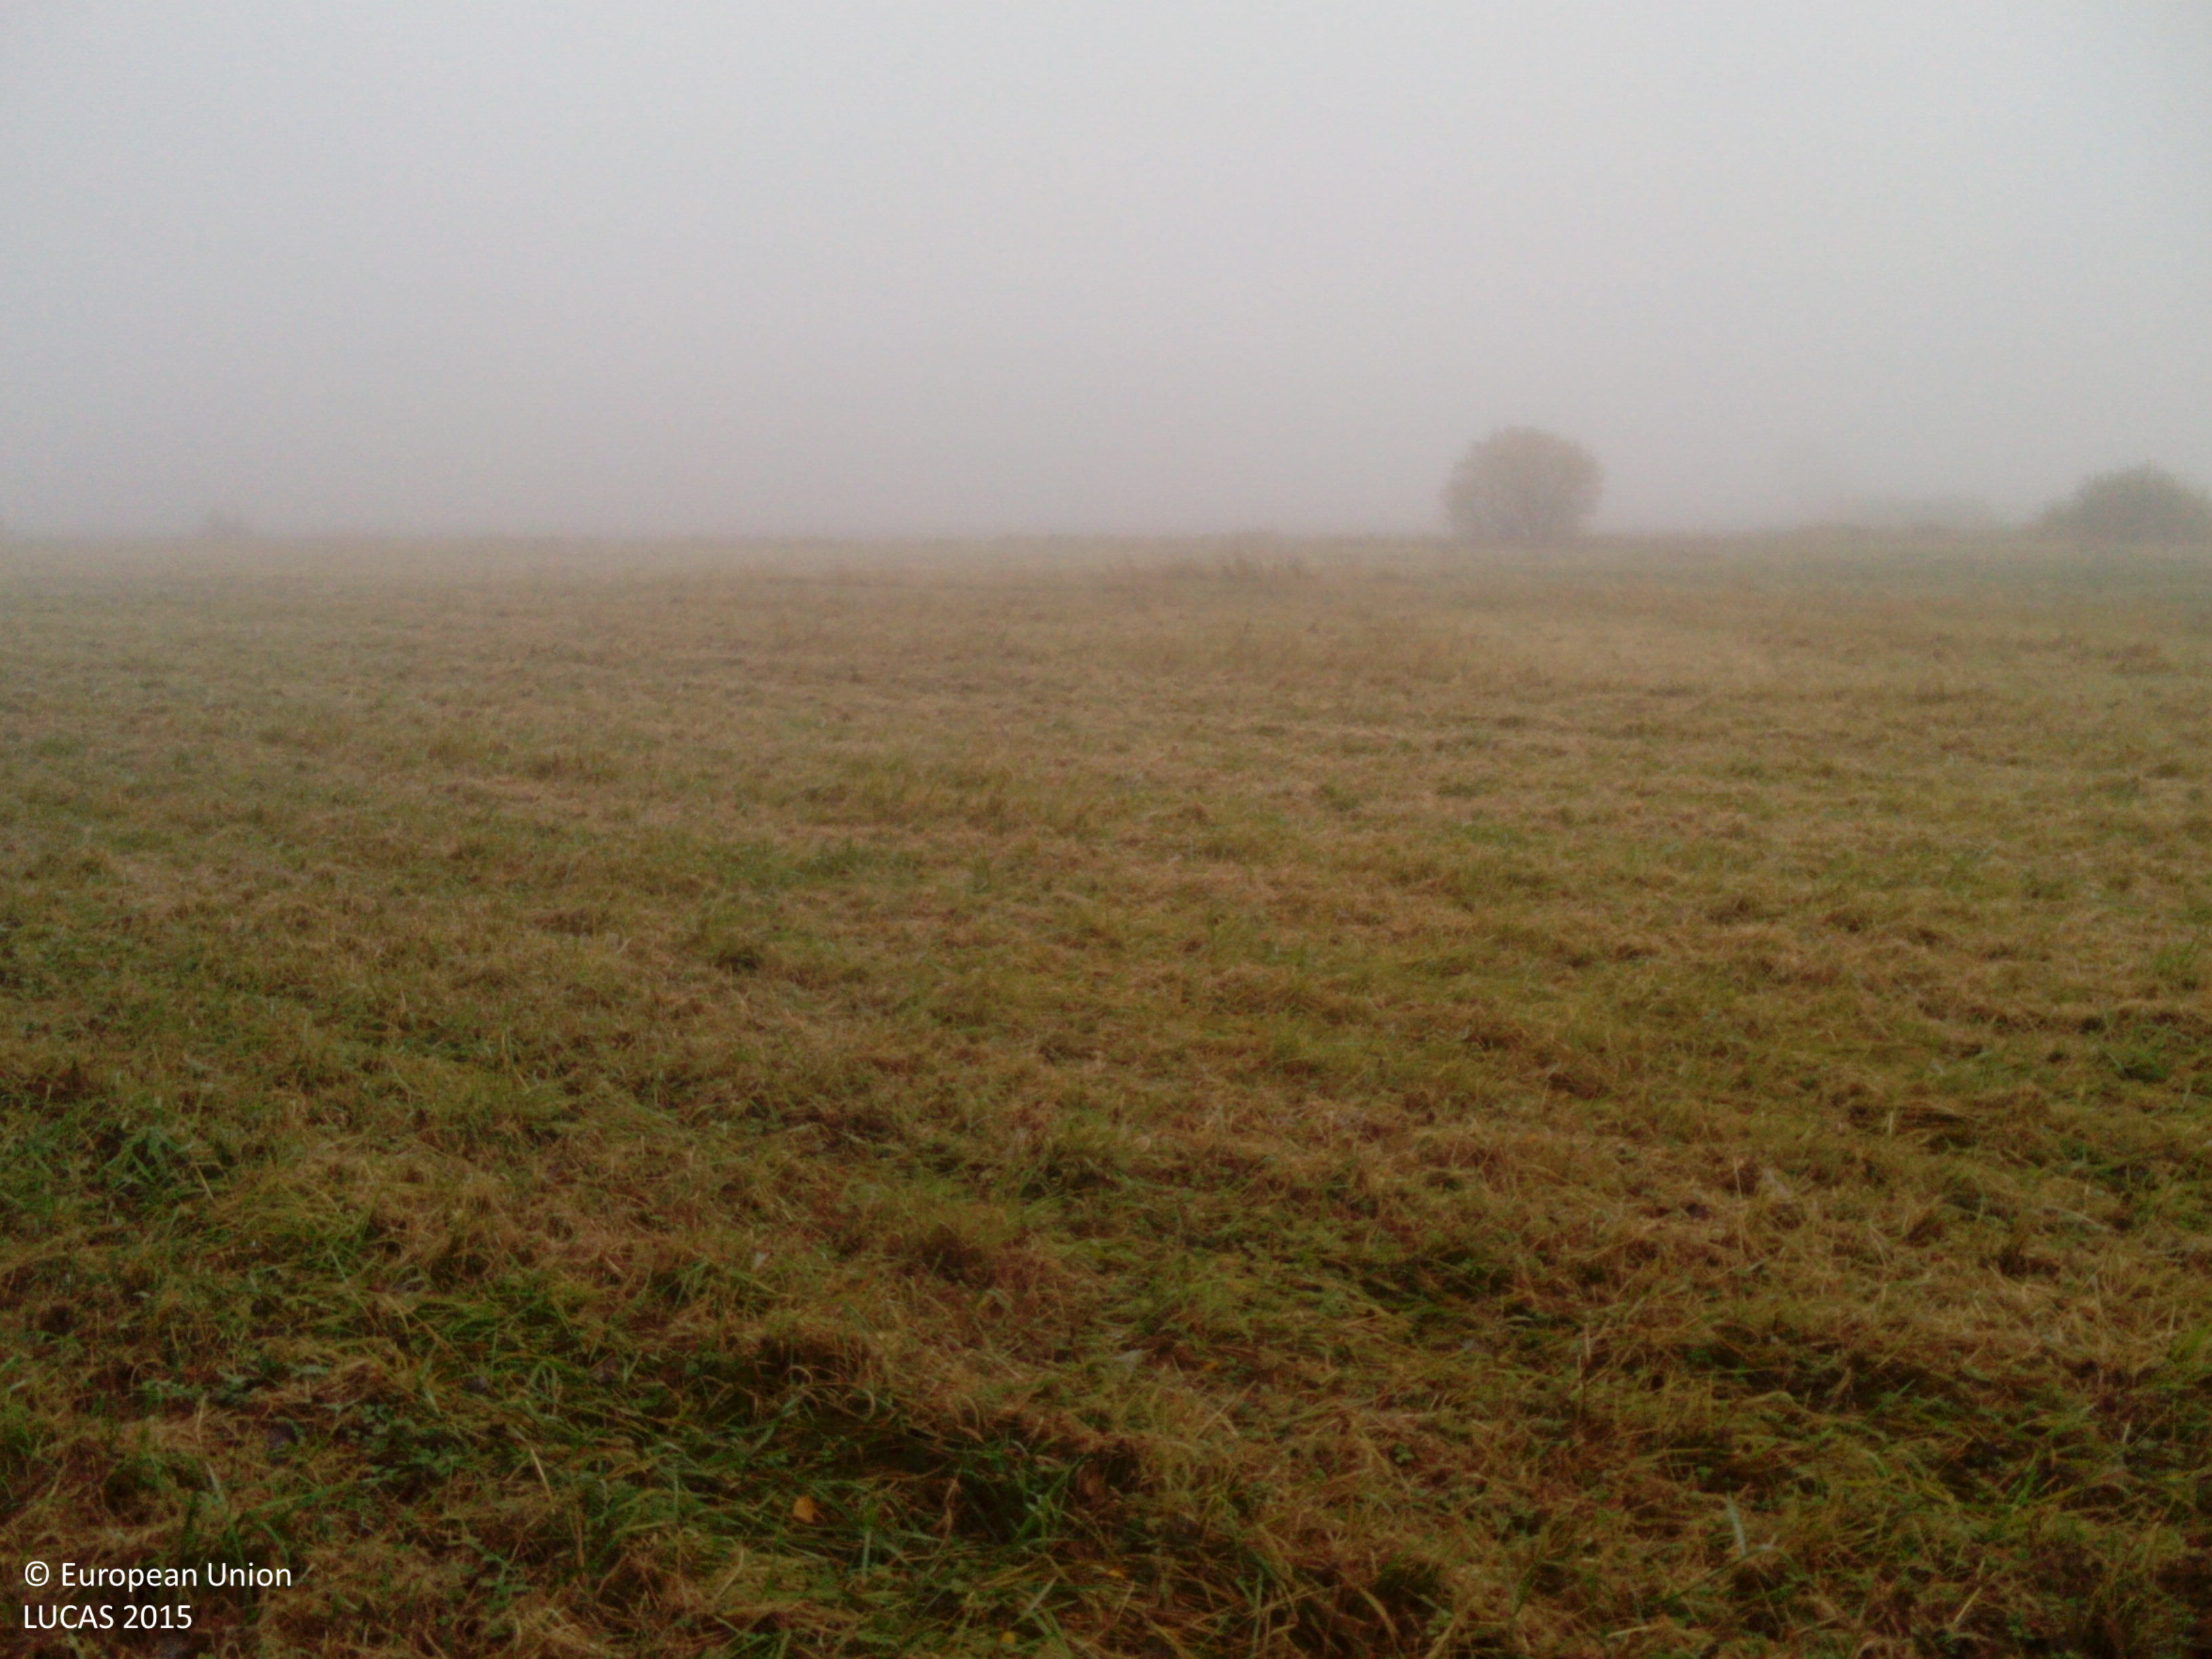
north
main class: Grassland
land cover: Grassland without tree/shrub cover
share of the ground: > 75 %
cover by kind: herbaceous plants 100 %
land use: Agriculture (excluding fallow land and kitchen gardens)
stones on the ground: < 10 %
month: October
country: SE
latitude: 58.8273
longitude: 16.7334
